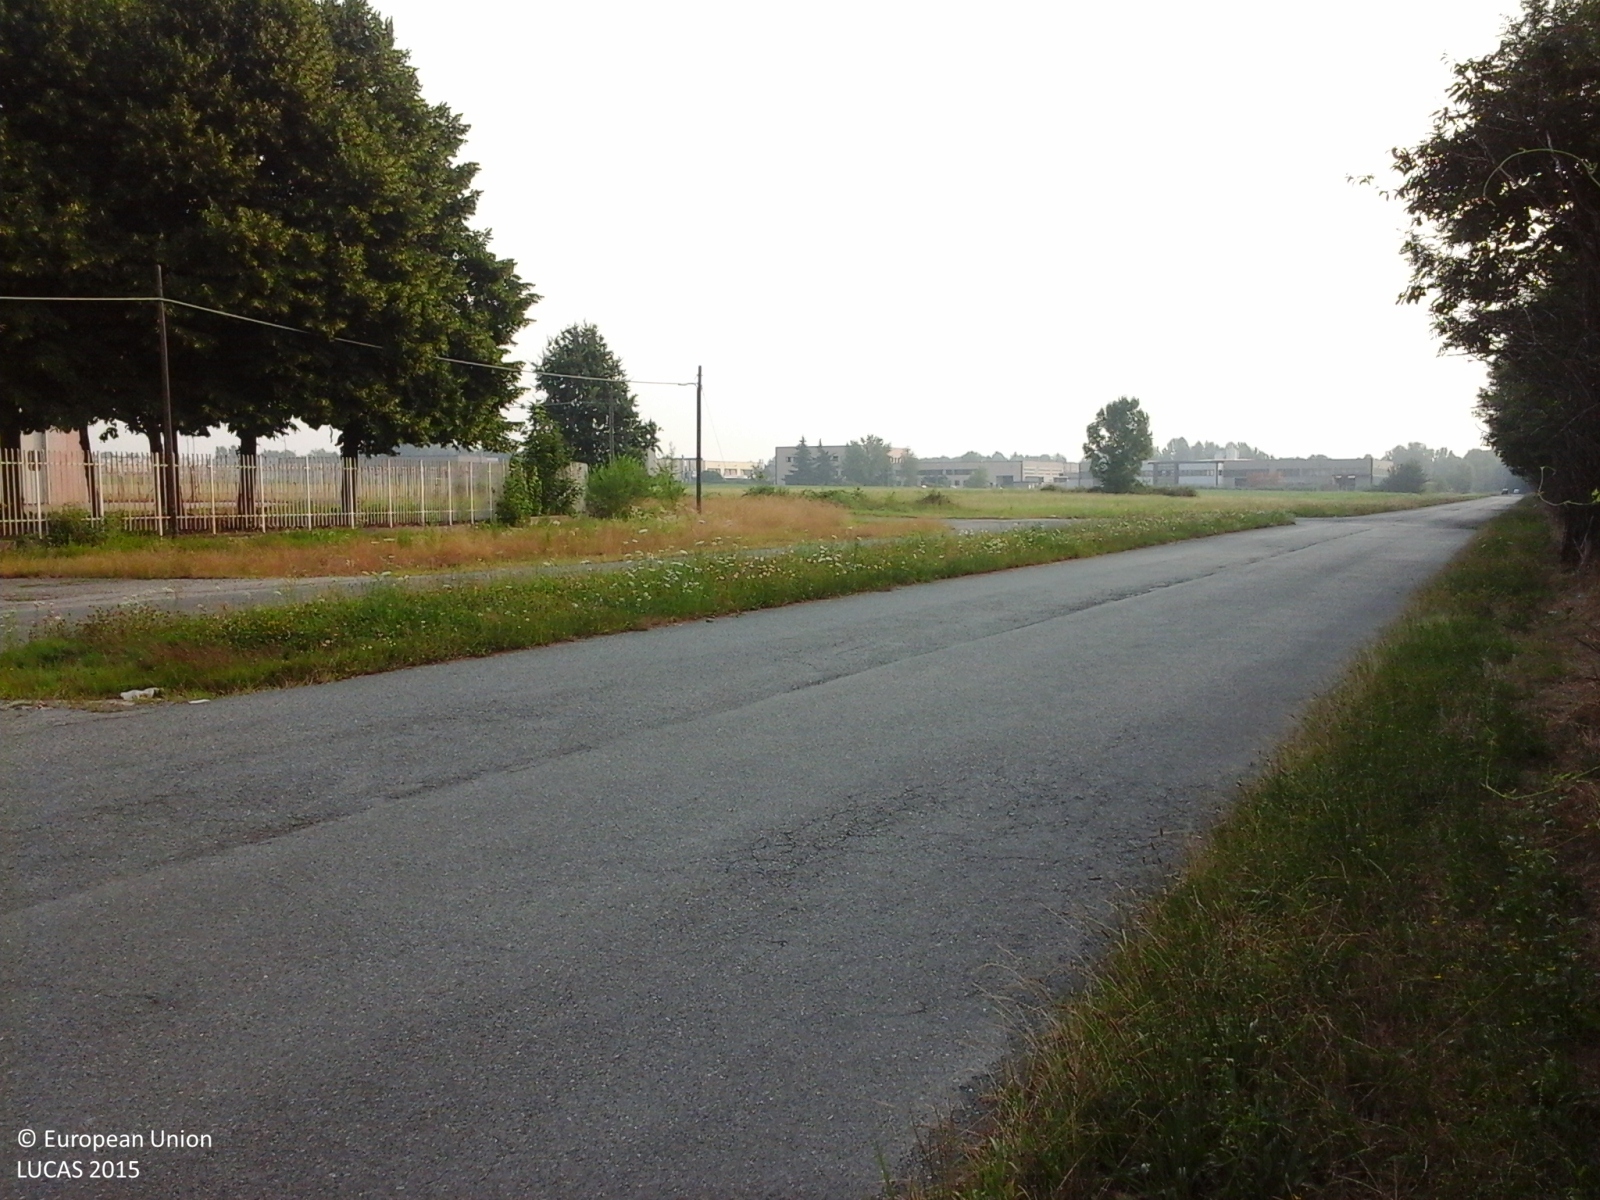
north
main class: Woodland
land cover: Broadleaved woodland
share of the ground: > 75 %
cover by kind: broadleaved forest trees 100 %
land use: Semi-natural and natural areas not in use
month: July
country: IT
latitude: 45.1706
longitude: 7.5993
